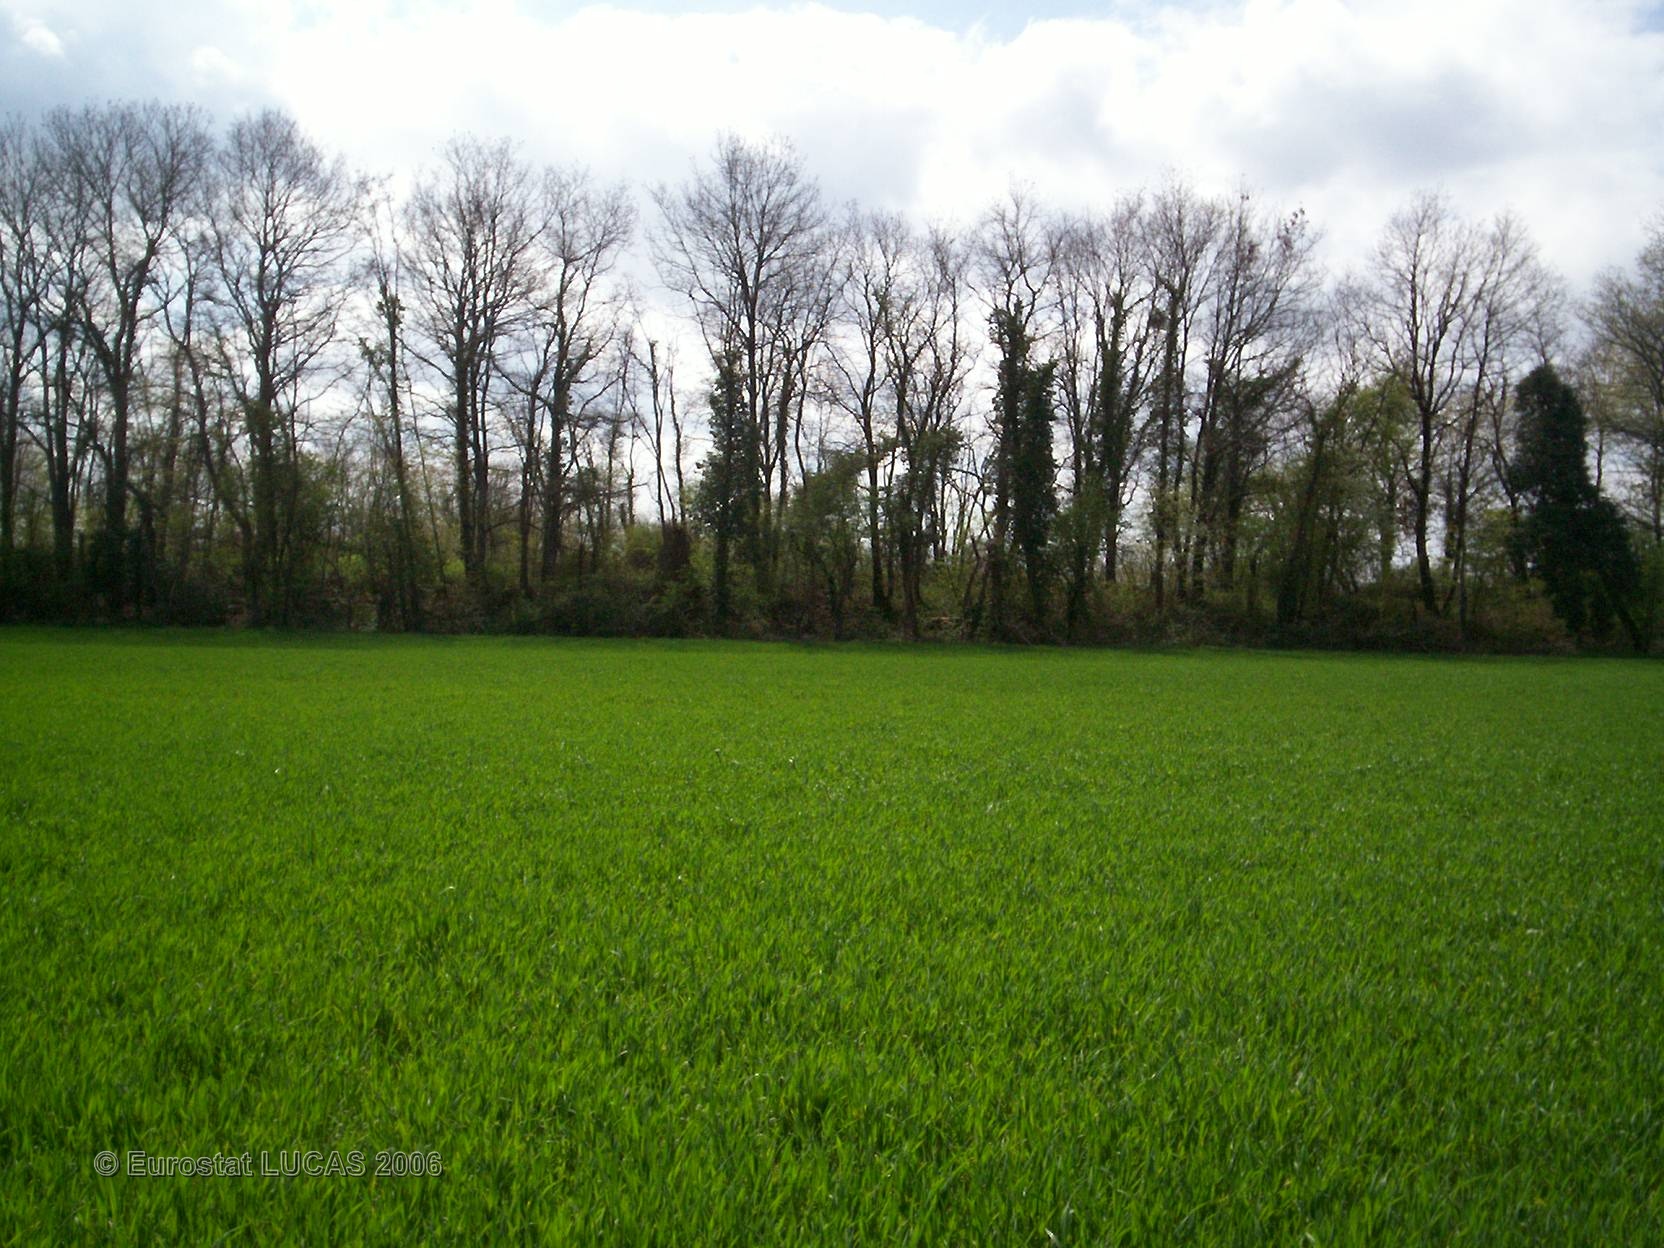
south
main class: Cropland
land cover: Common wheat
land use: Agriculture (excluding fallow land and kitchen gardens)
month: April
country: FR
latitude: 46.2118
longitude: 0.6393
